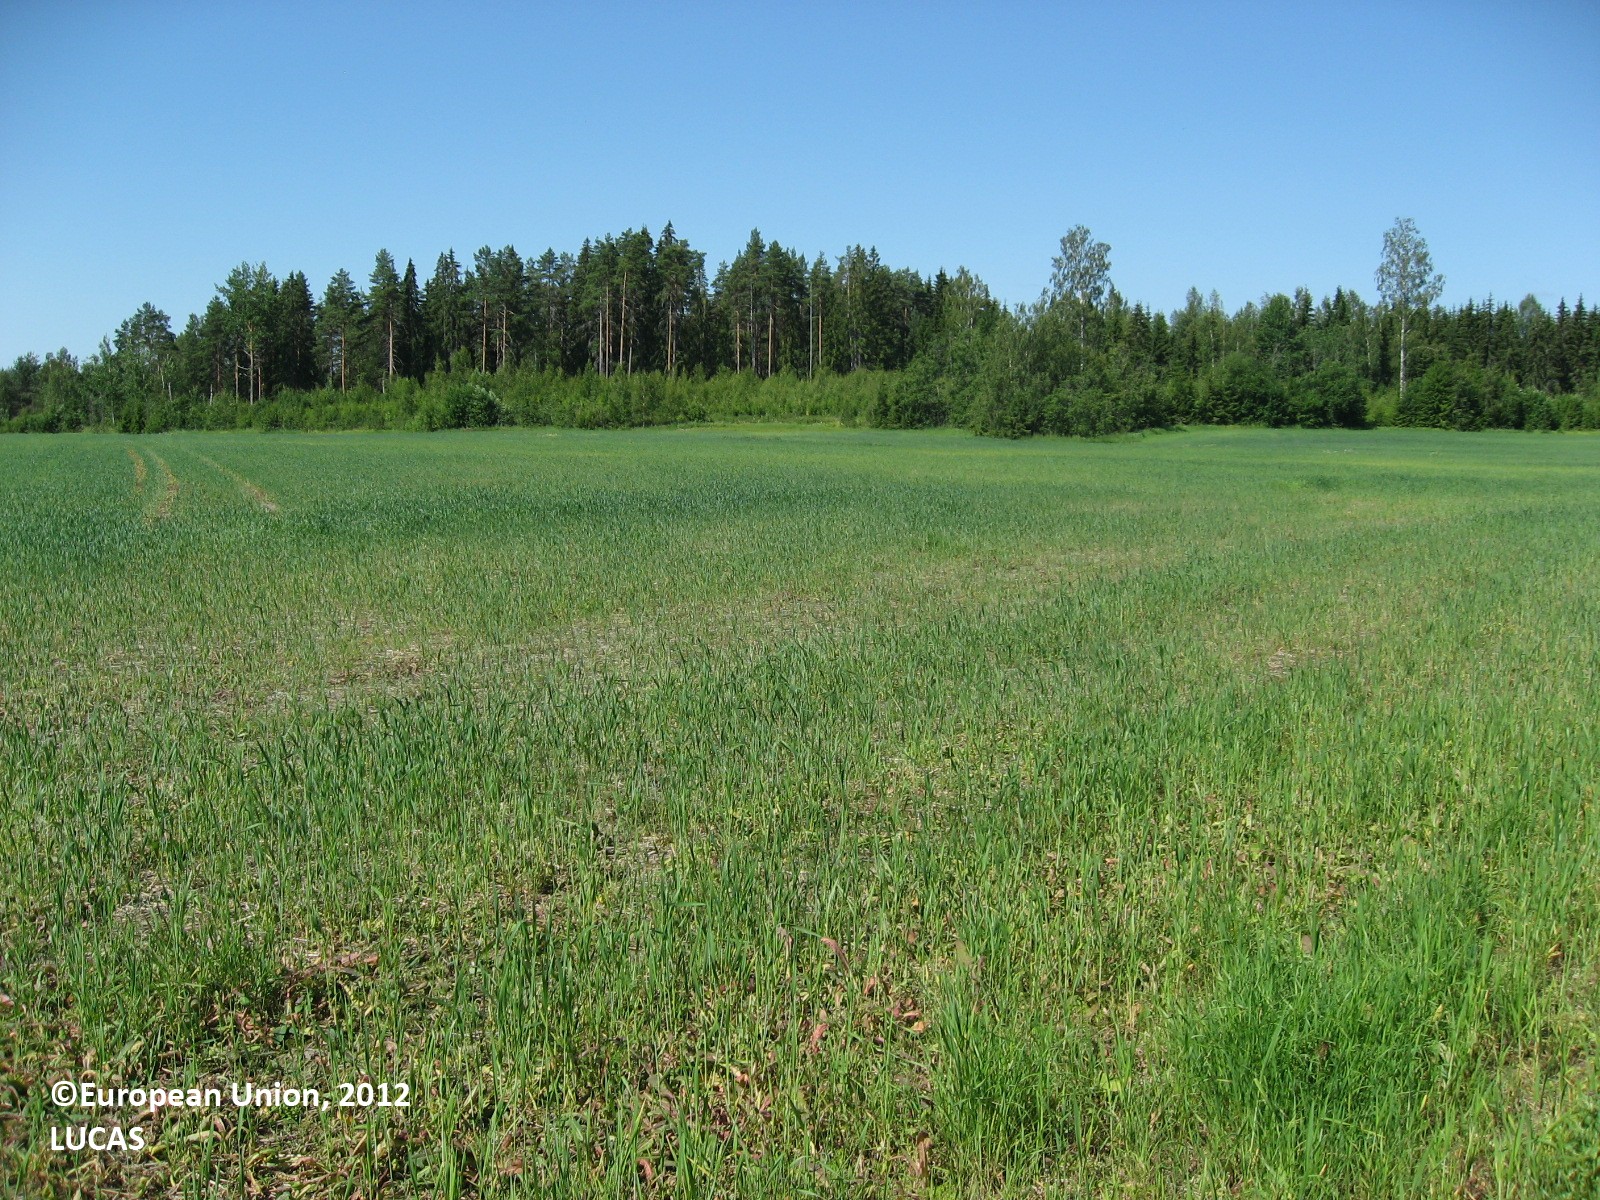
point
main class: Cropland
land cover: Common wheat
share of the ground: 50 - 75 %
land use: Agriculture (excluding fallow land and kitchen gardens)
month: July
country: FI
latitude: 60.9665
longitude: 26.5374
